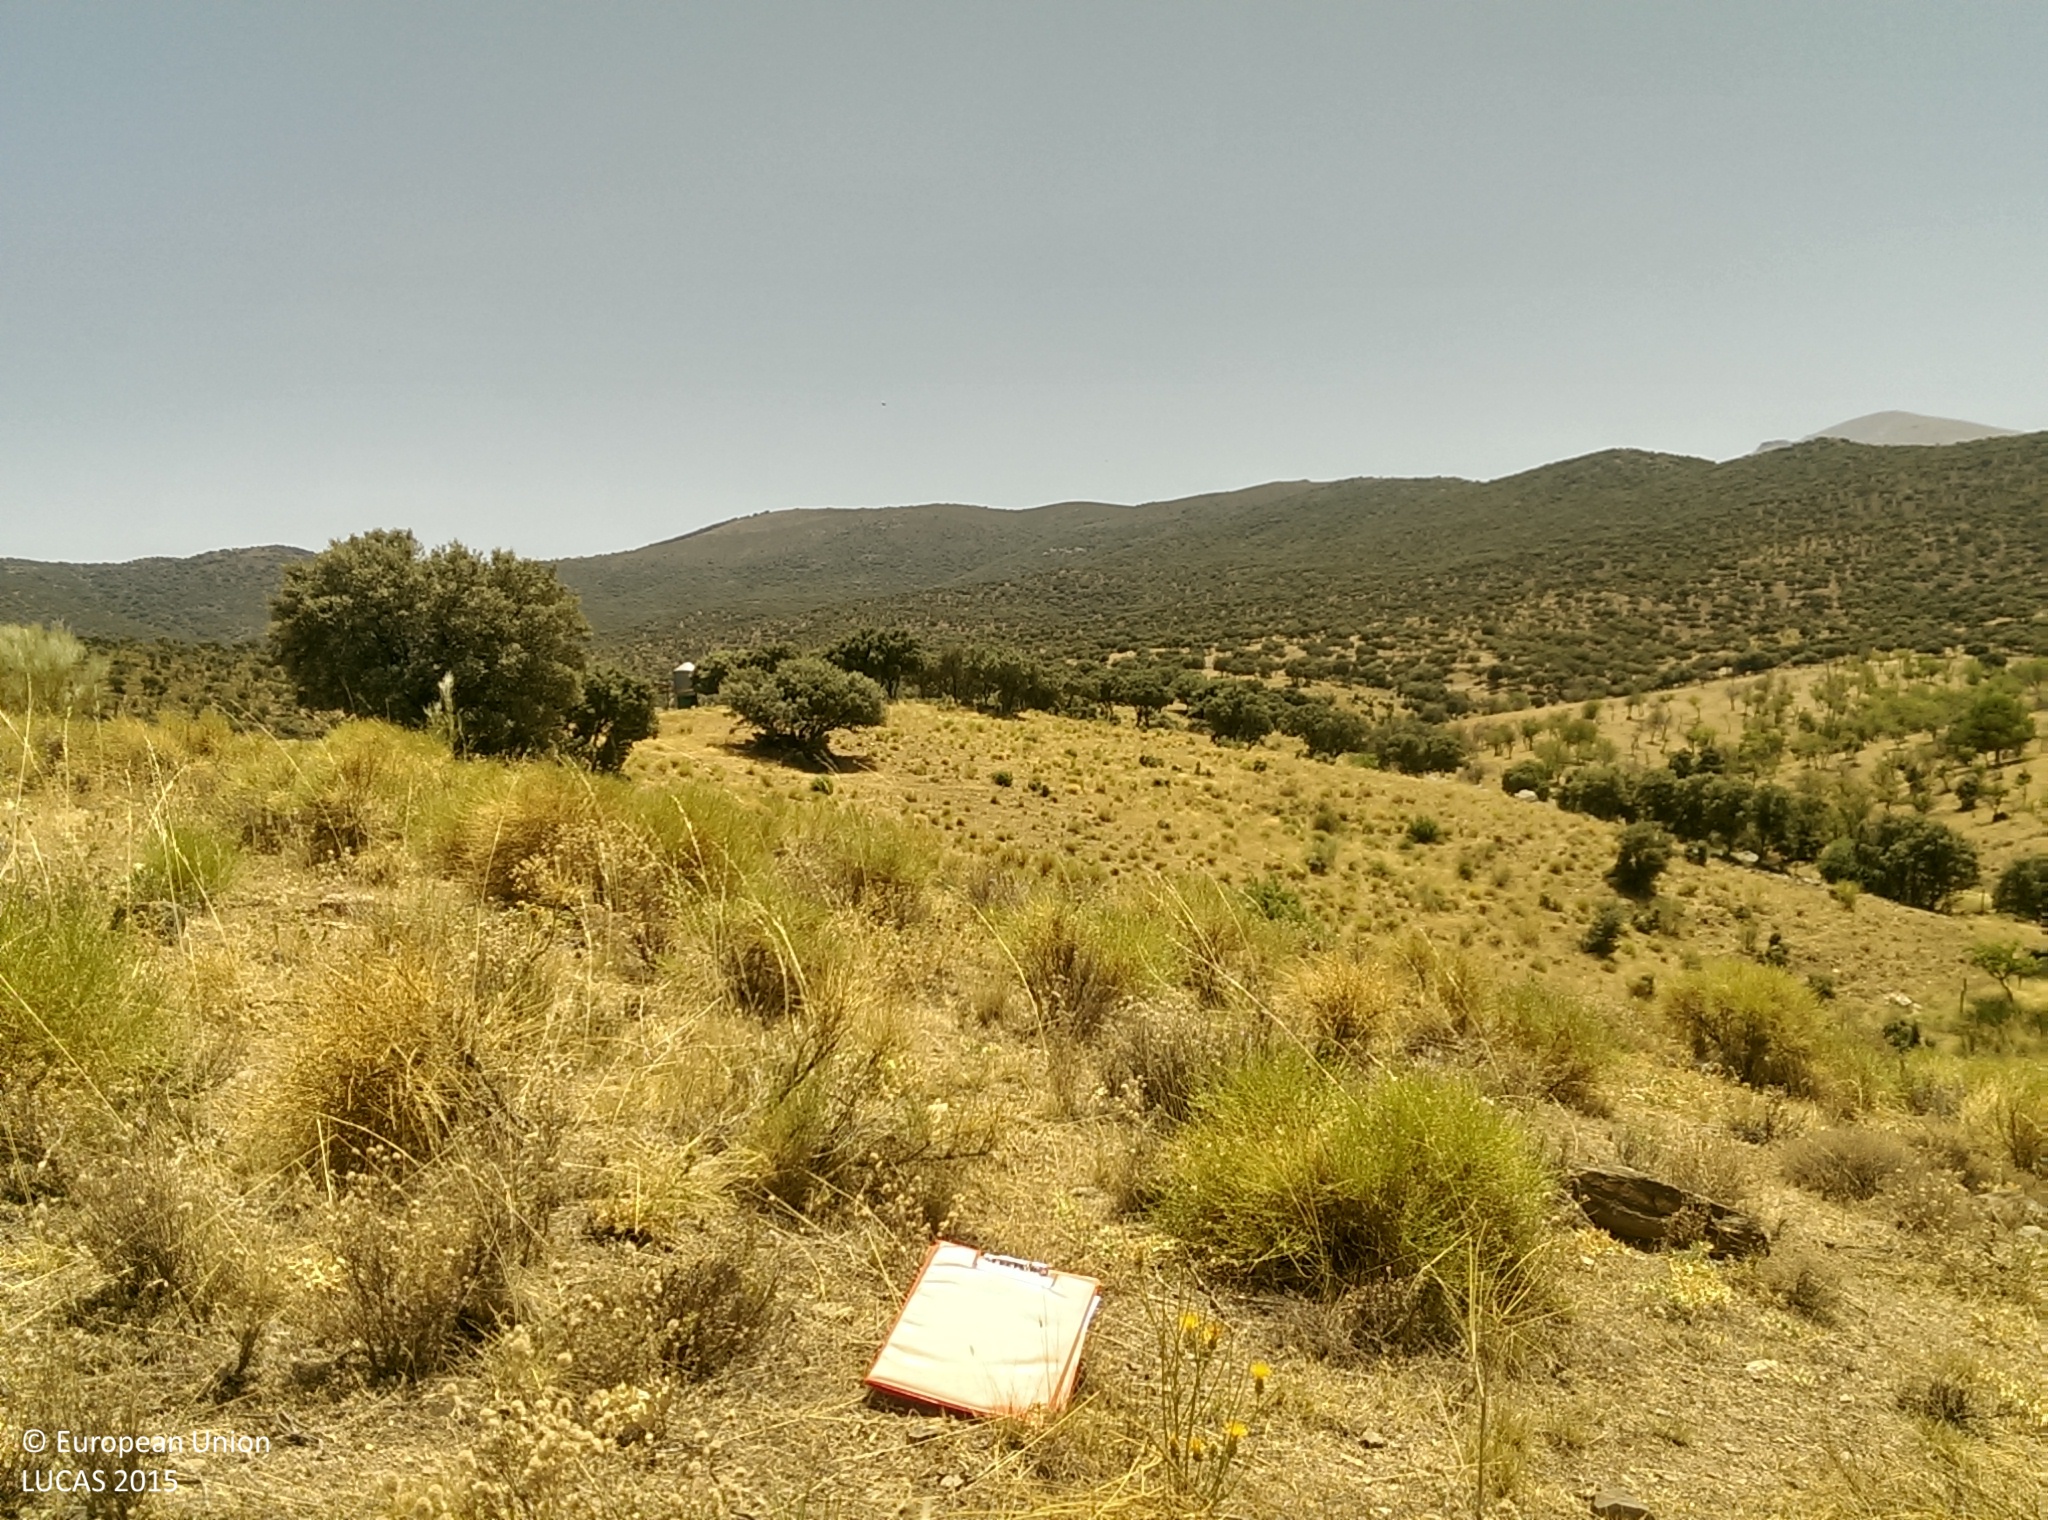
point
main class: Shrubland
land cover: Shrubland without tree cover
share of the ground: 25 - 50 %
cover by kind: shrubs 45 %, herbaceous plants 40 %, unconsolidated bare surface 15 %
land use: Agriculture (excluding fallow land and kitchen gardens)
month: July
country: ES
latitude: 37.2227
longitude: -3.2289
